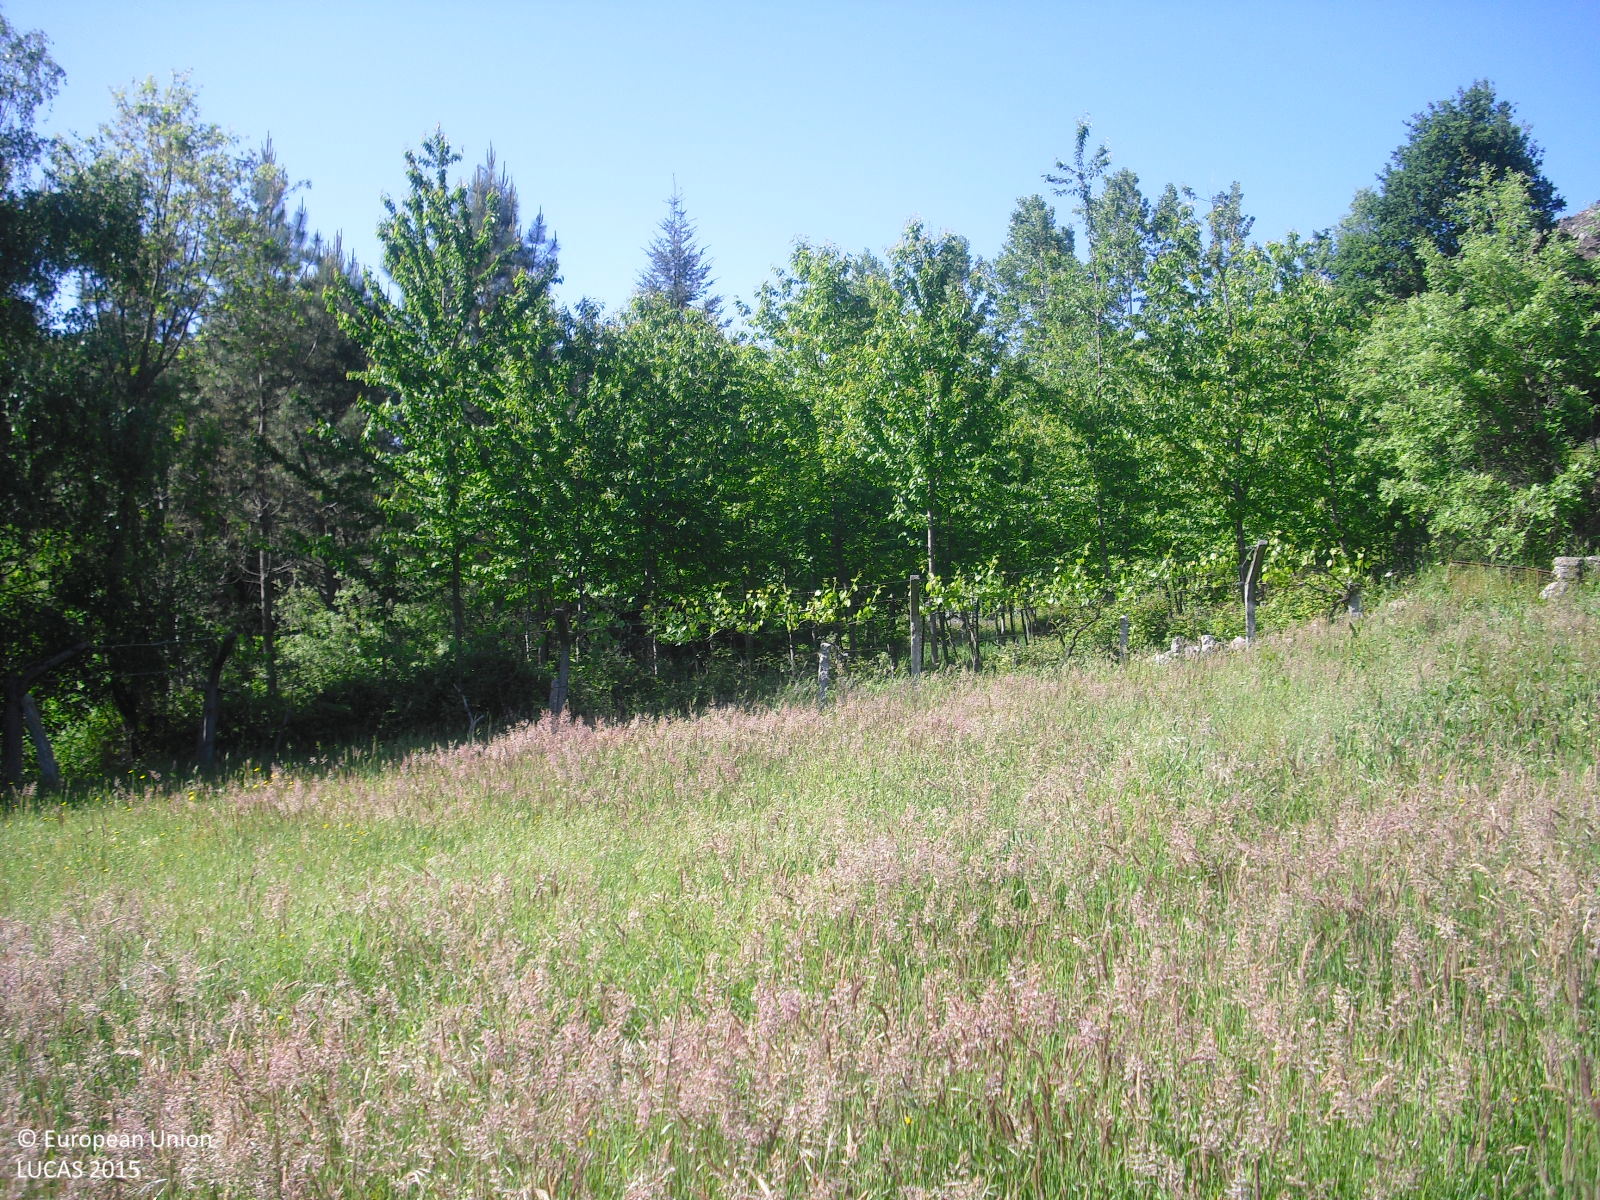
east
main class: Grassland
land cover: Grassland without tree/shrub cover
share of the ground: > 75 %
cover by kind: herbaceous plants 100 %
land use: Agriculture (excluding fallow land and kitchen gardens)
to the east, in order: Grassland without tree/shrub cover; Ditches and canals; Grassland without tree/shrub cover; Single bushes/trees; Grassland without tree/shrub cover; Shrubland with sparse tree cover; Broadleaved woodland; Dry stone walls; Shruby margins; Tracks; Grass margins; Tracks; Shruby margins; Grass margins; Tracks; Pine dominated mixed woodland
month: May
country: ES
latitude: 41.9596
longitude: -8.1413
